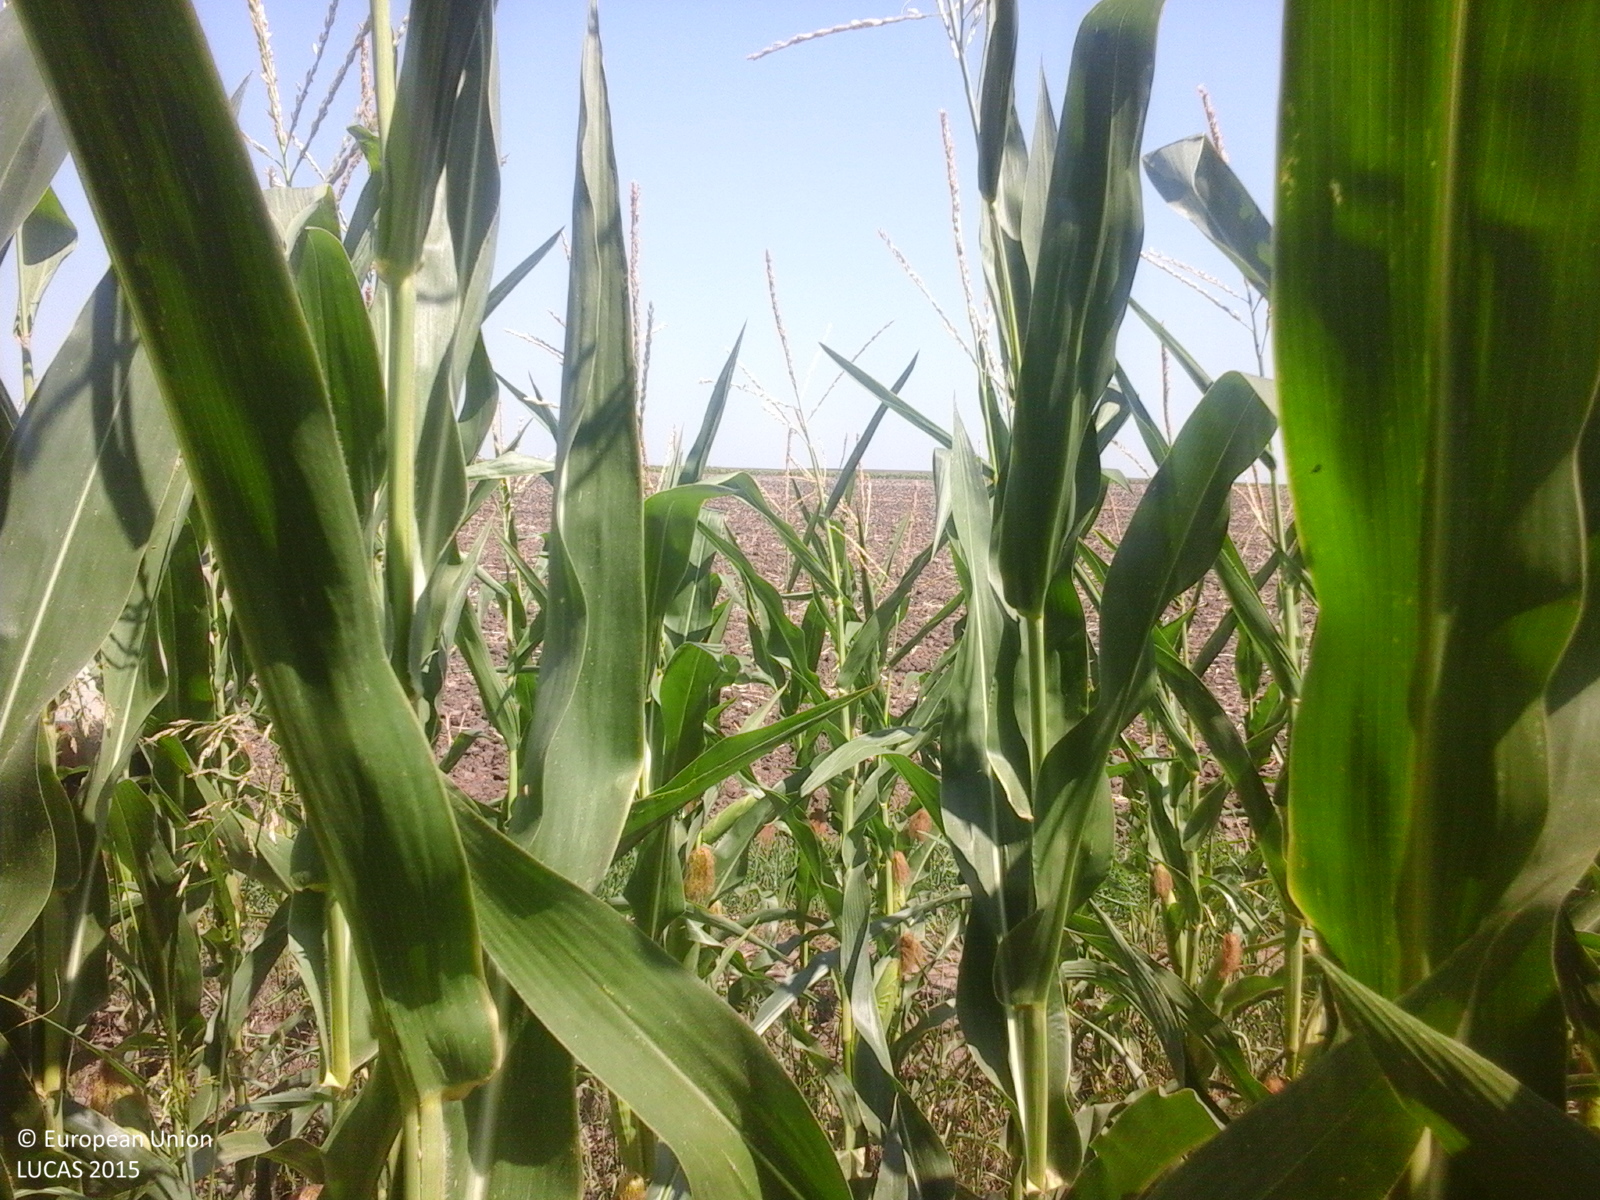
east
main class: Cropland
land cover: Maize
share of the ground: > 75 %
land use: Agriculture (excluding fallow land and kitchen gardens)
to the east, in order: Maize; Tracks; Rape and turnip rape
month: July
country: RO
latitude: 44.2252
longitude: 26.6534
